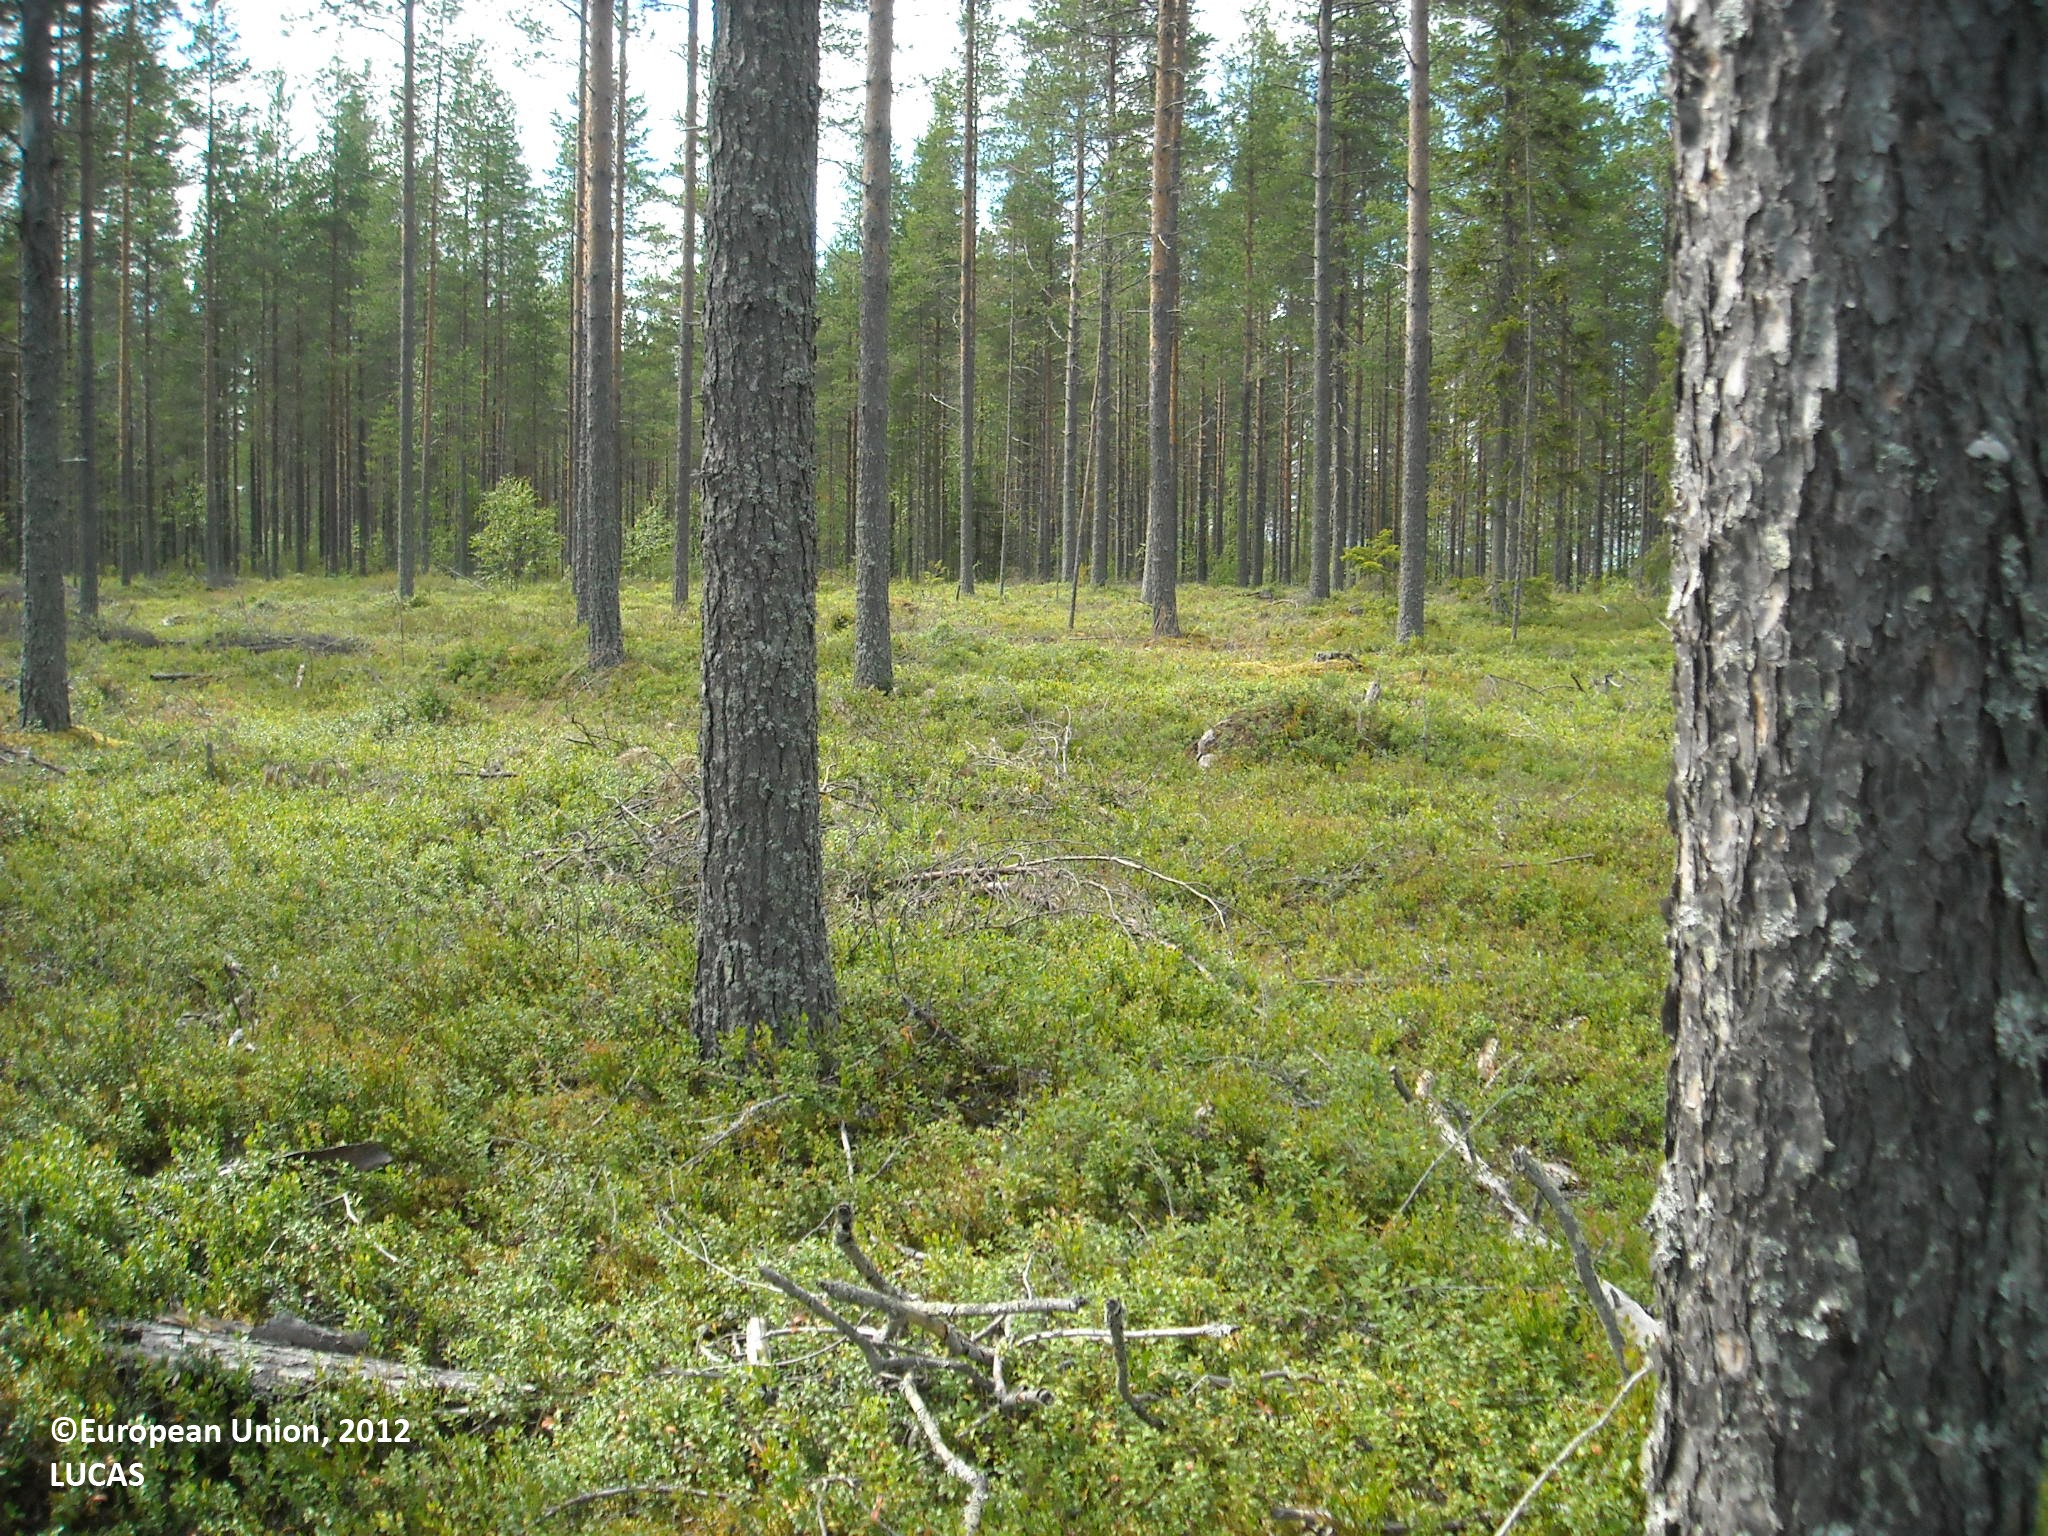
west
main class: Woodland
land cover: Pine dominated coniferous woodland
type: boreal forest
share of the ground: 25 - 50 %
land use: Forestry
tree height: > 5 m
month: July
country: FI
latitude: 64.9789
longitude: 26.9671
